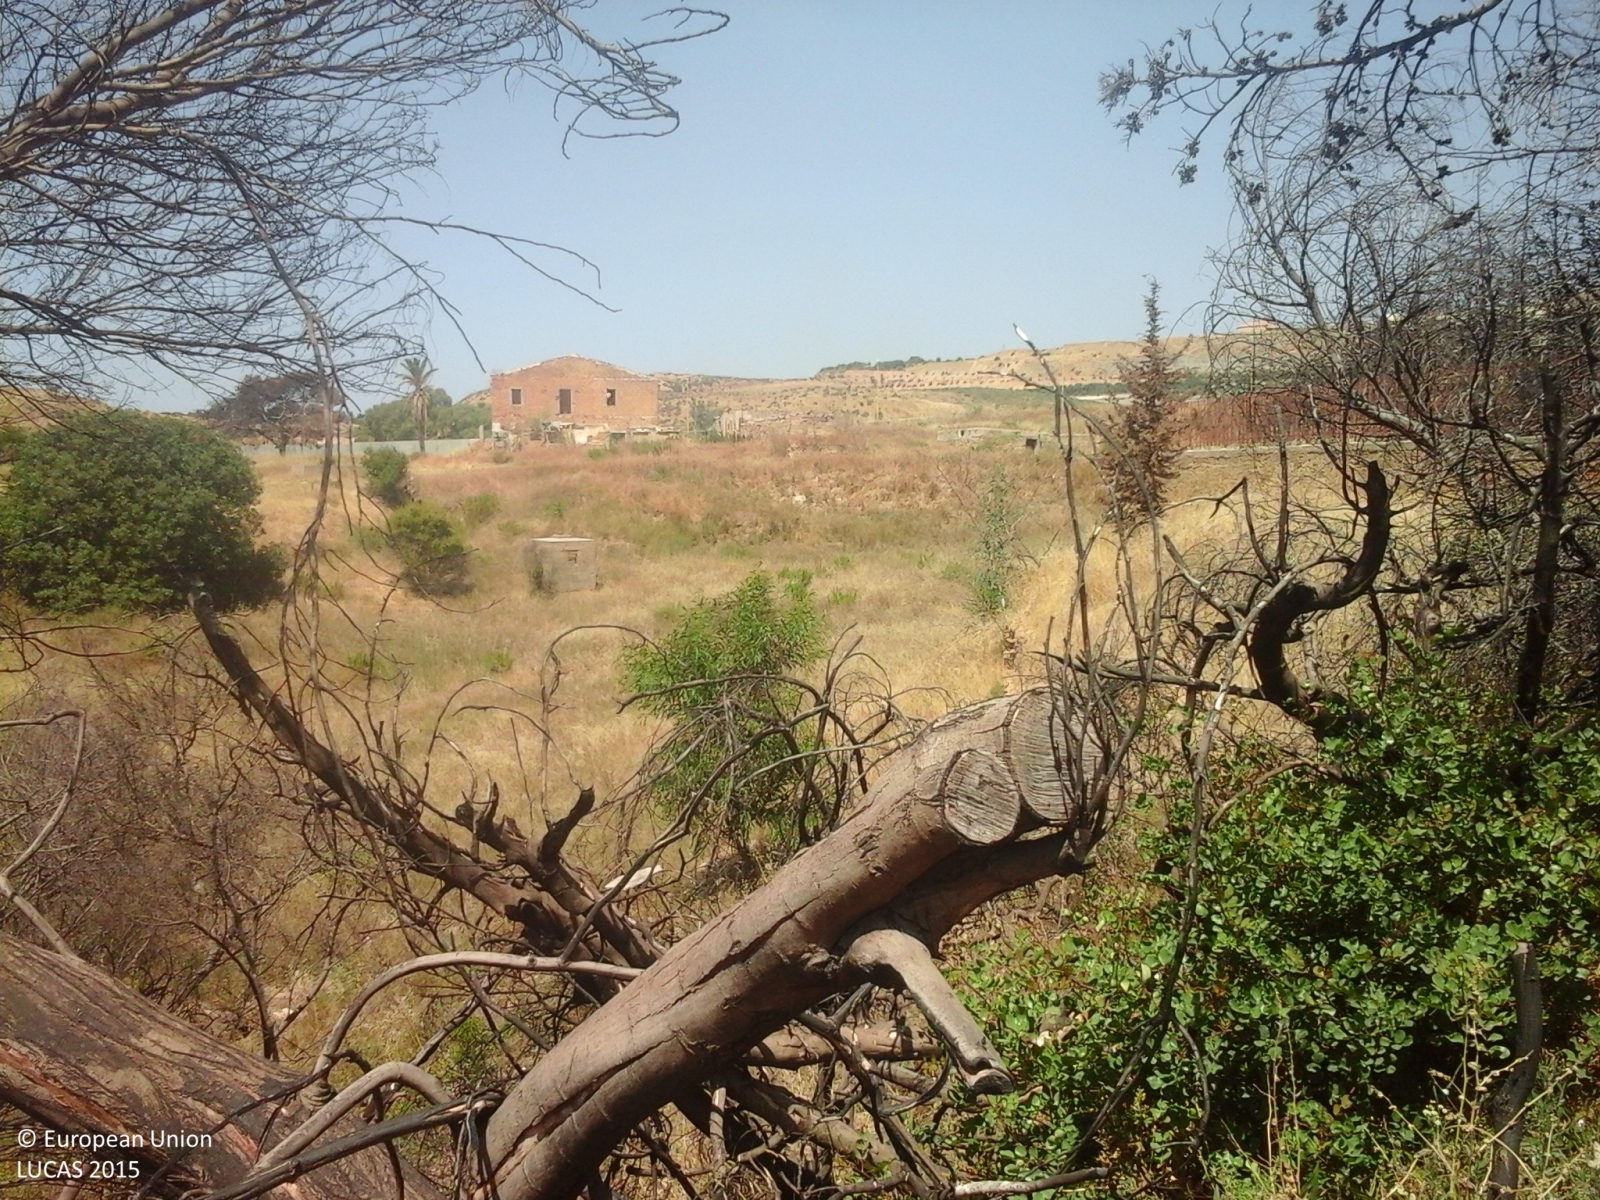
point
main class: Grassland
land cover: Grassland without tree/shrub cover
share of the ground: > 75 %
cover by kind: herbaceous plants 100 %
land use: Abandoned areas
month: July
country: IT
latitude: 37.2997
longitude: 13.5485
